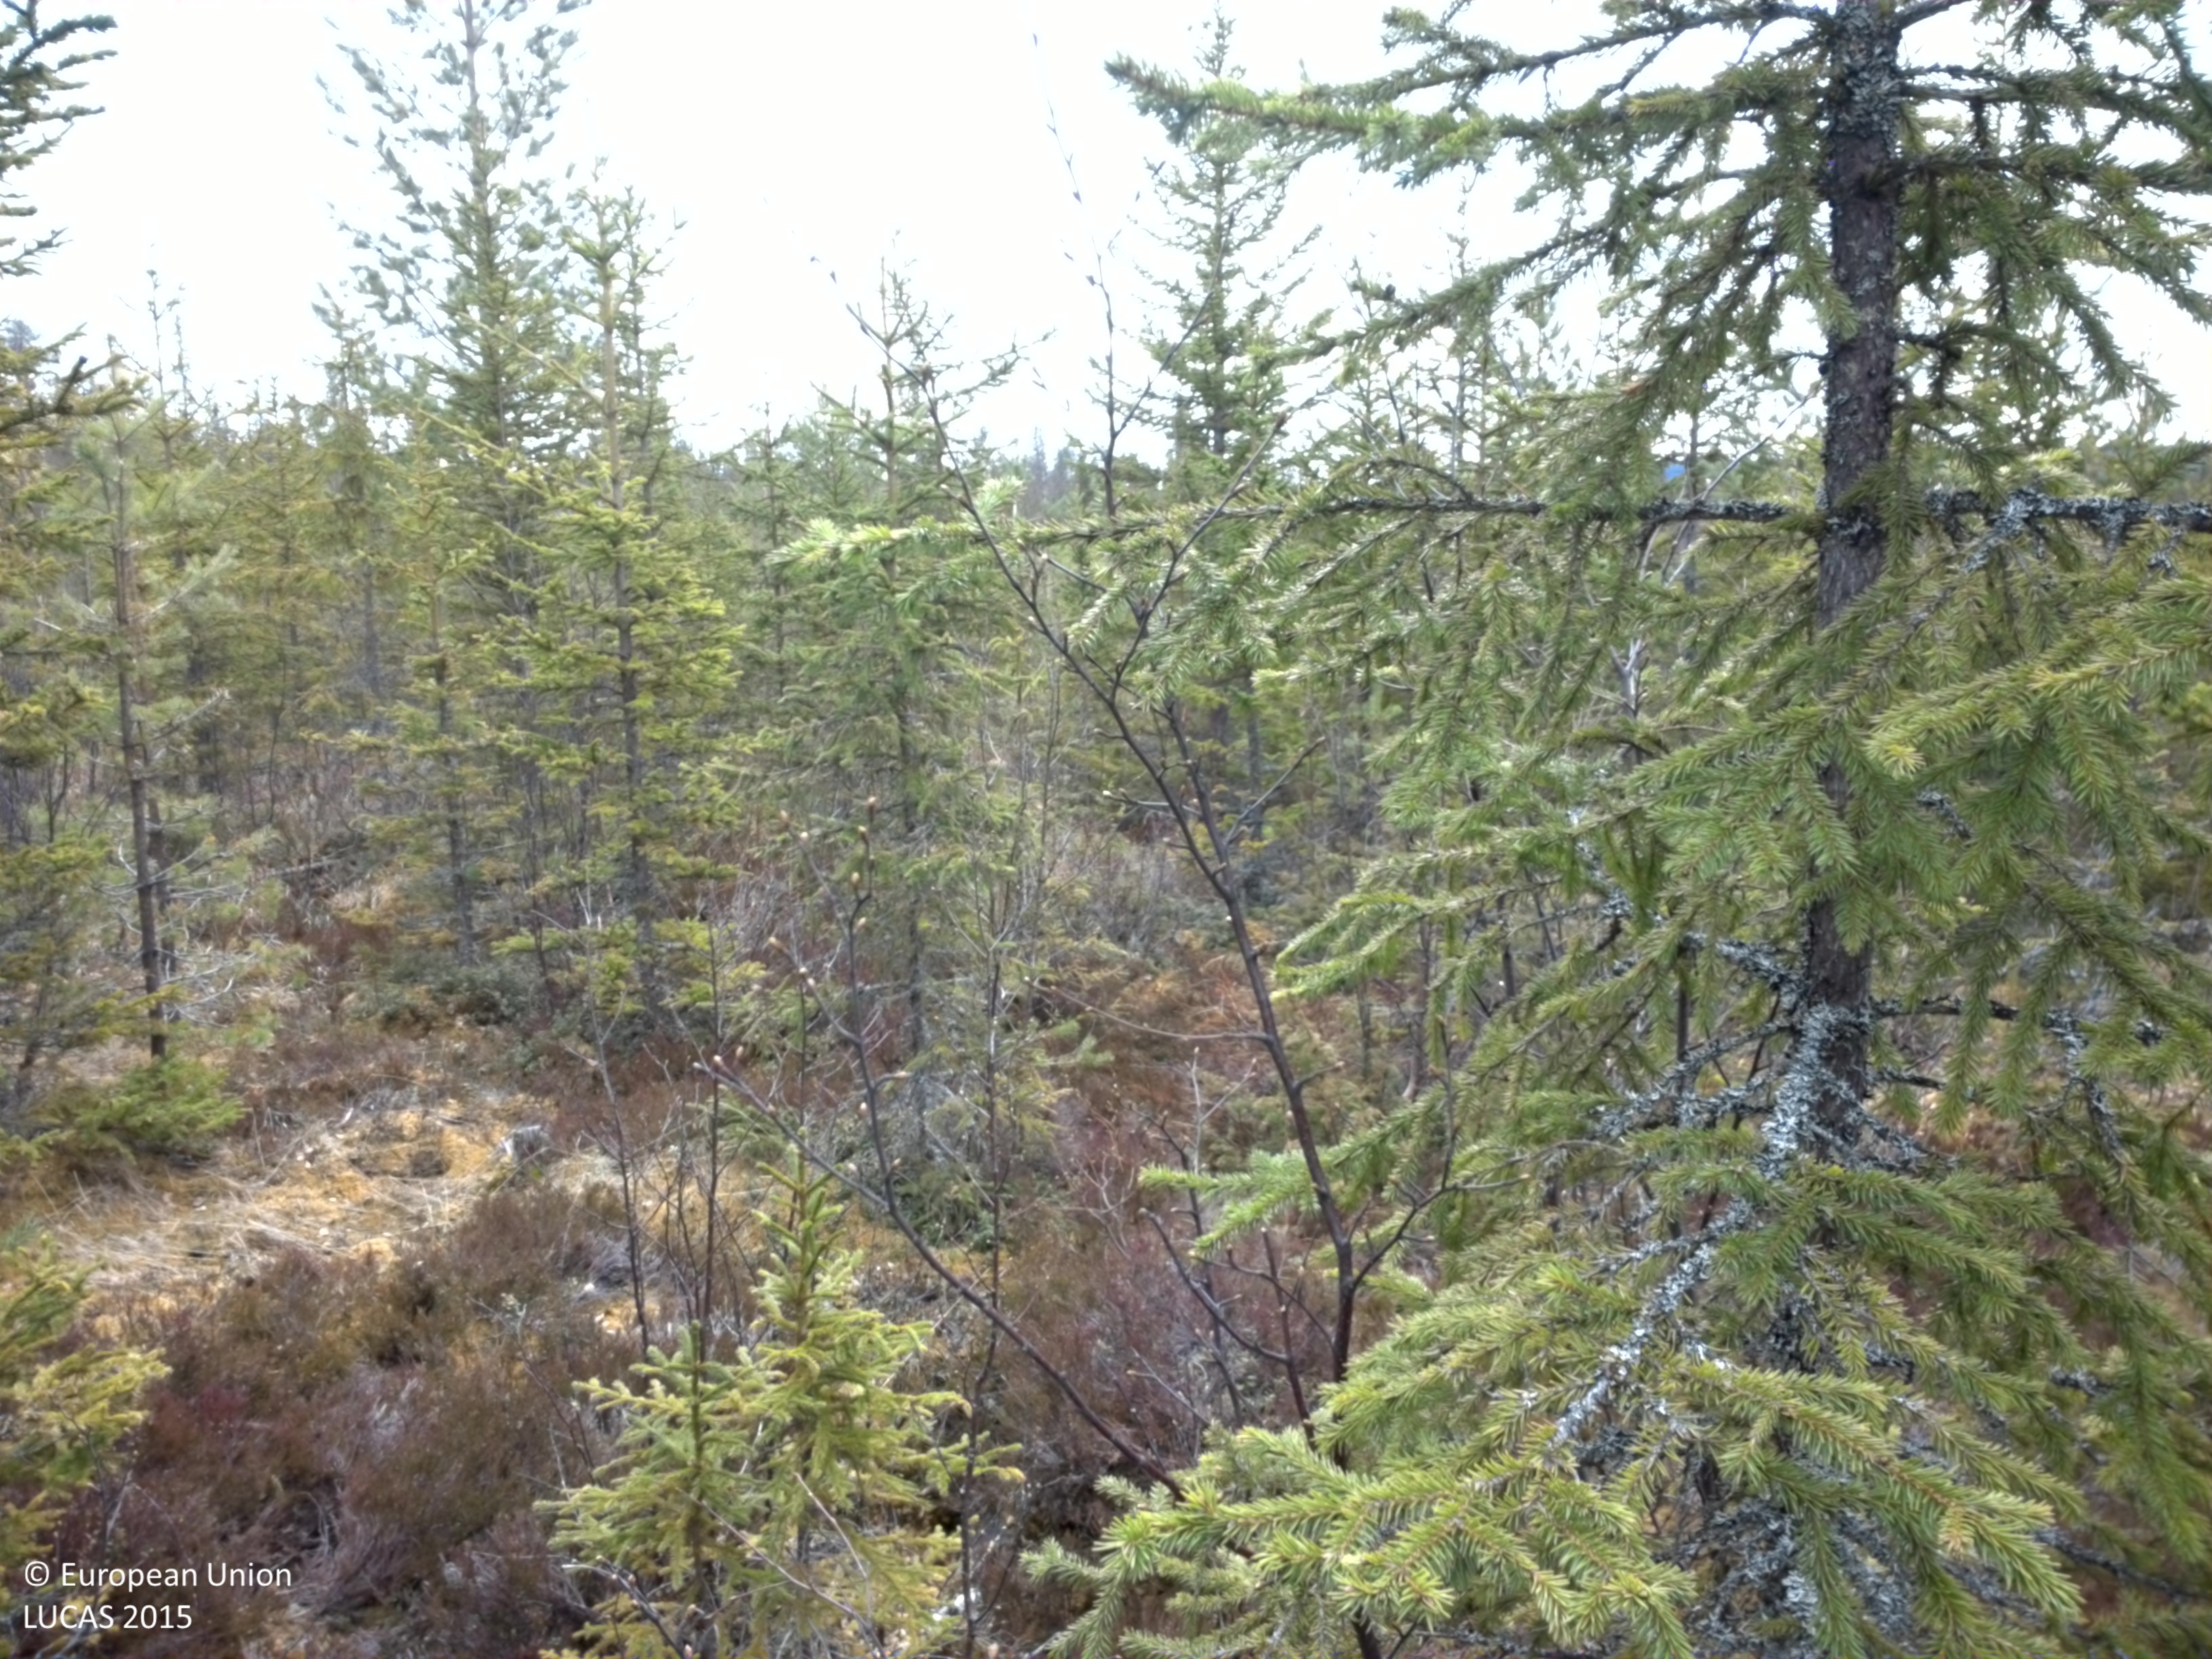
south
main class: Woodland
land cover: Spruce dominated coniferous woodland
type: boreal forest
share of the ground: > 75 %
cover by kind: coniferous forest trees 80 %, shrubs 20 %
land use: Forestry
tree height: > 5 m
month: May
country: SE
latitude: 62.6190
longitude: 14.4446
